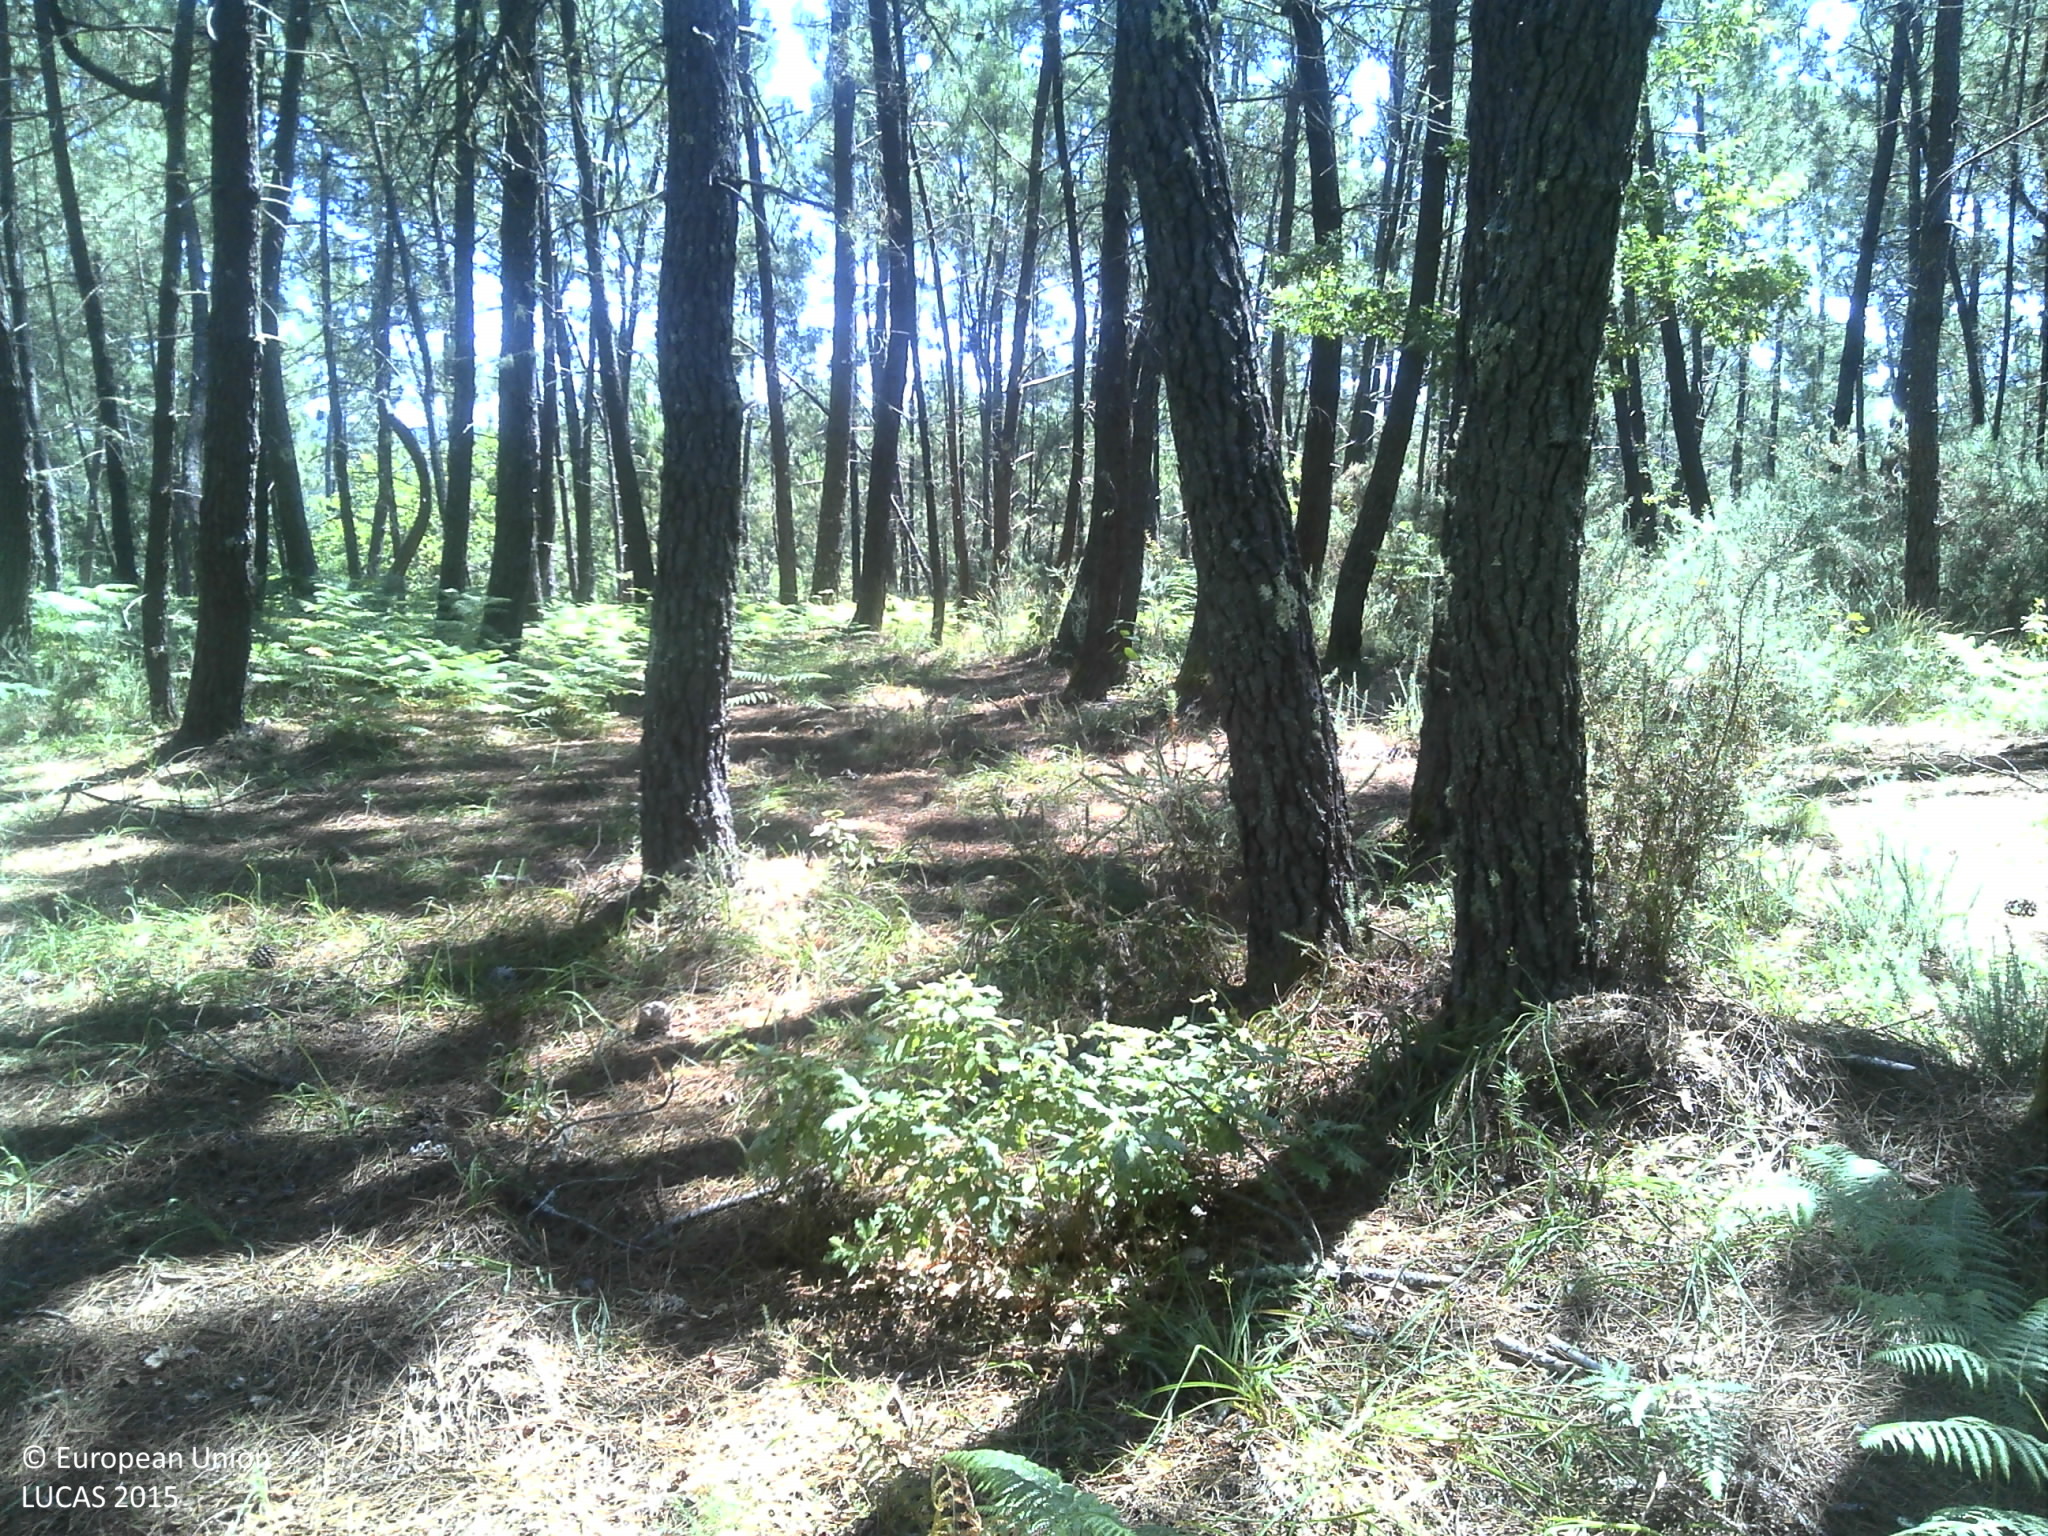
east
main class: Woodland
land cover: Pine dominated coniferous woodland
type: coniferous forest of the mediterranean region
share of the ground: 50 - 75 %
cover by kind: coniferous forest trees 70 %, shrubs 20 %, broadleaved forest trees 5 %, unconsolidated bare surface 5 %
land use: Forestry
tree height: > 5 m
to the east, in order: Pine dominated coniferous woodland; Tracks; Pine dominated mixed woodland; Dry stone walls; Shrubland with sparse tree cover; Tracks; Shrubland without tree cover; Dry stone walls; Broadleaved woodland; Pine dominated coniferous woodland; Broadleaved woodland; Pine dominated mixed woodland; Dry stone walls; Pine dominated mixed woodland; Grassland with sparse tree/shrub cover
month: June
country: PT
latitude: 41.4135
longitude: -8.0995
